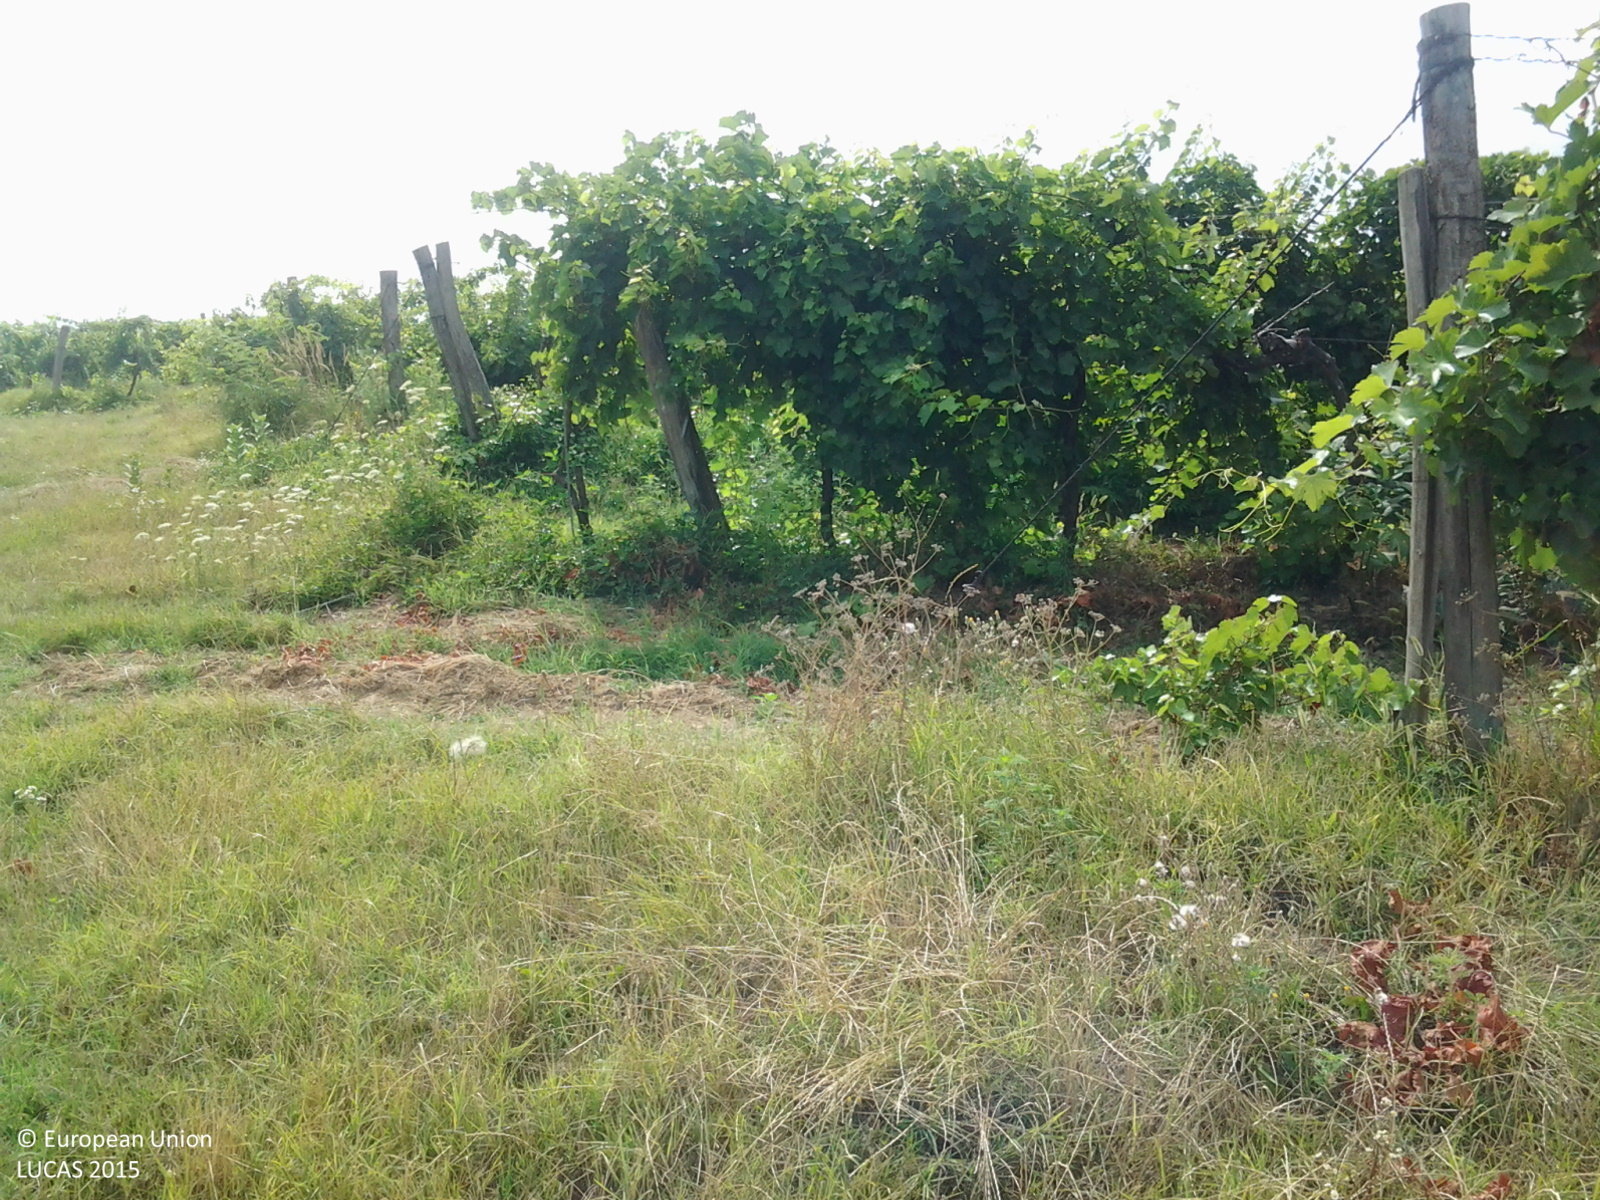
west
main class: Cropland
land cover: Vineyards
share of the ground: 50 - 75 %
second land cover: Spontaneously vegetated surfaces
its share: 25 - 50 %
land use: Agriculture (excluding fallow land and kitchen gardens)
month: July
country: HU
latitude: 46.4206
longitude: 18.3755
